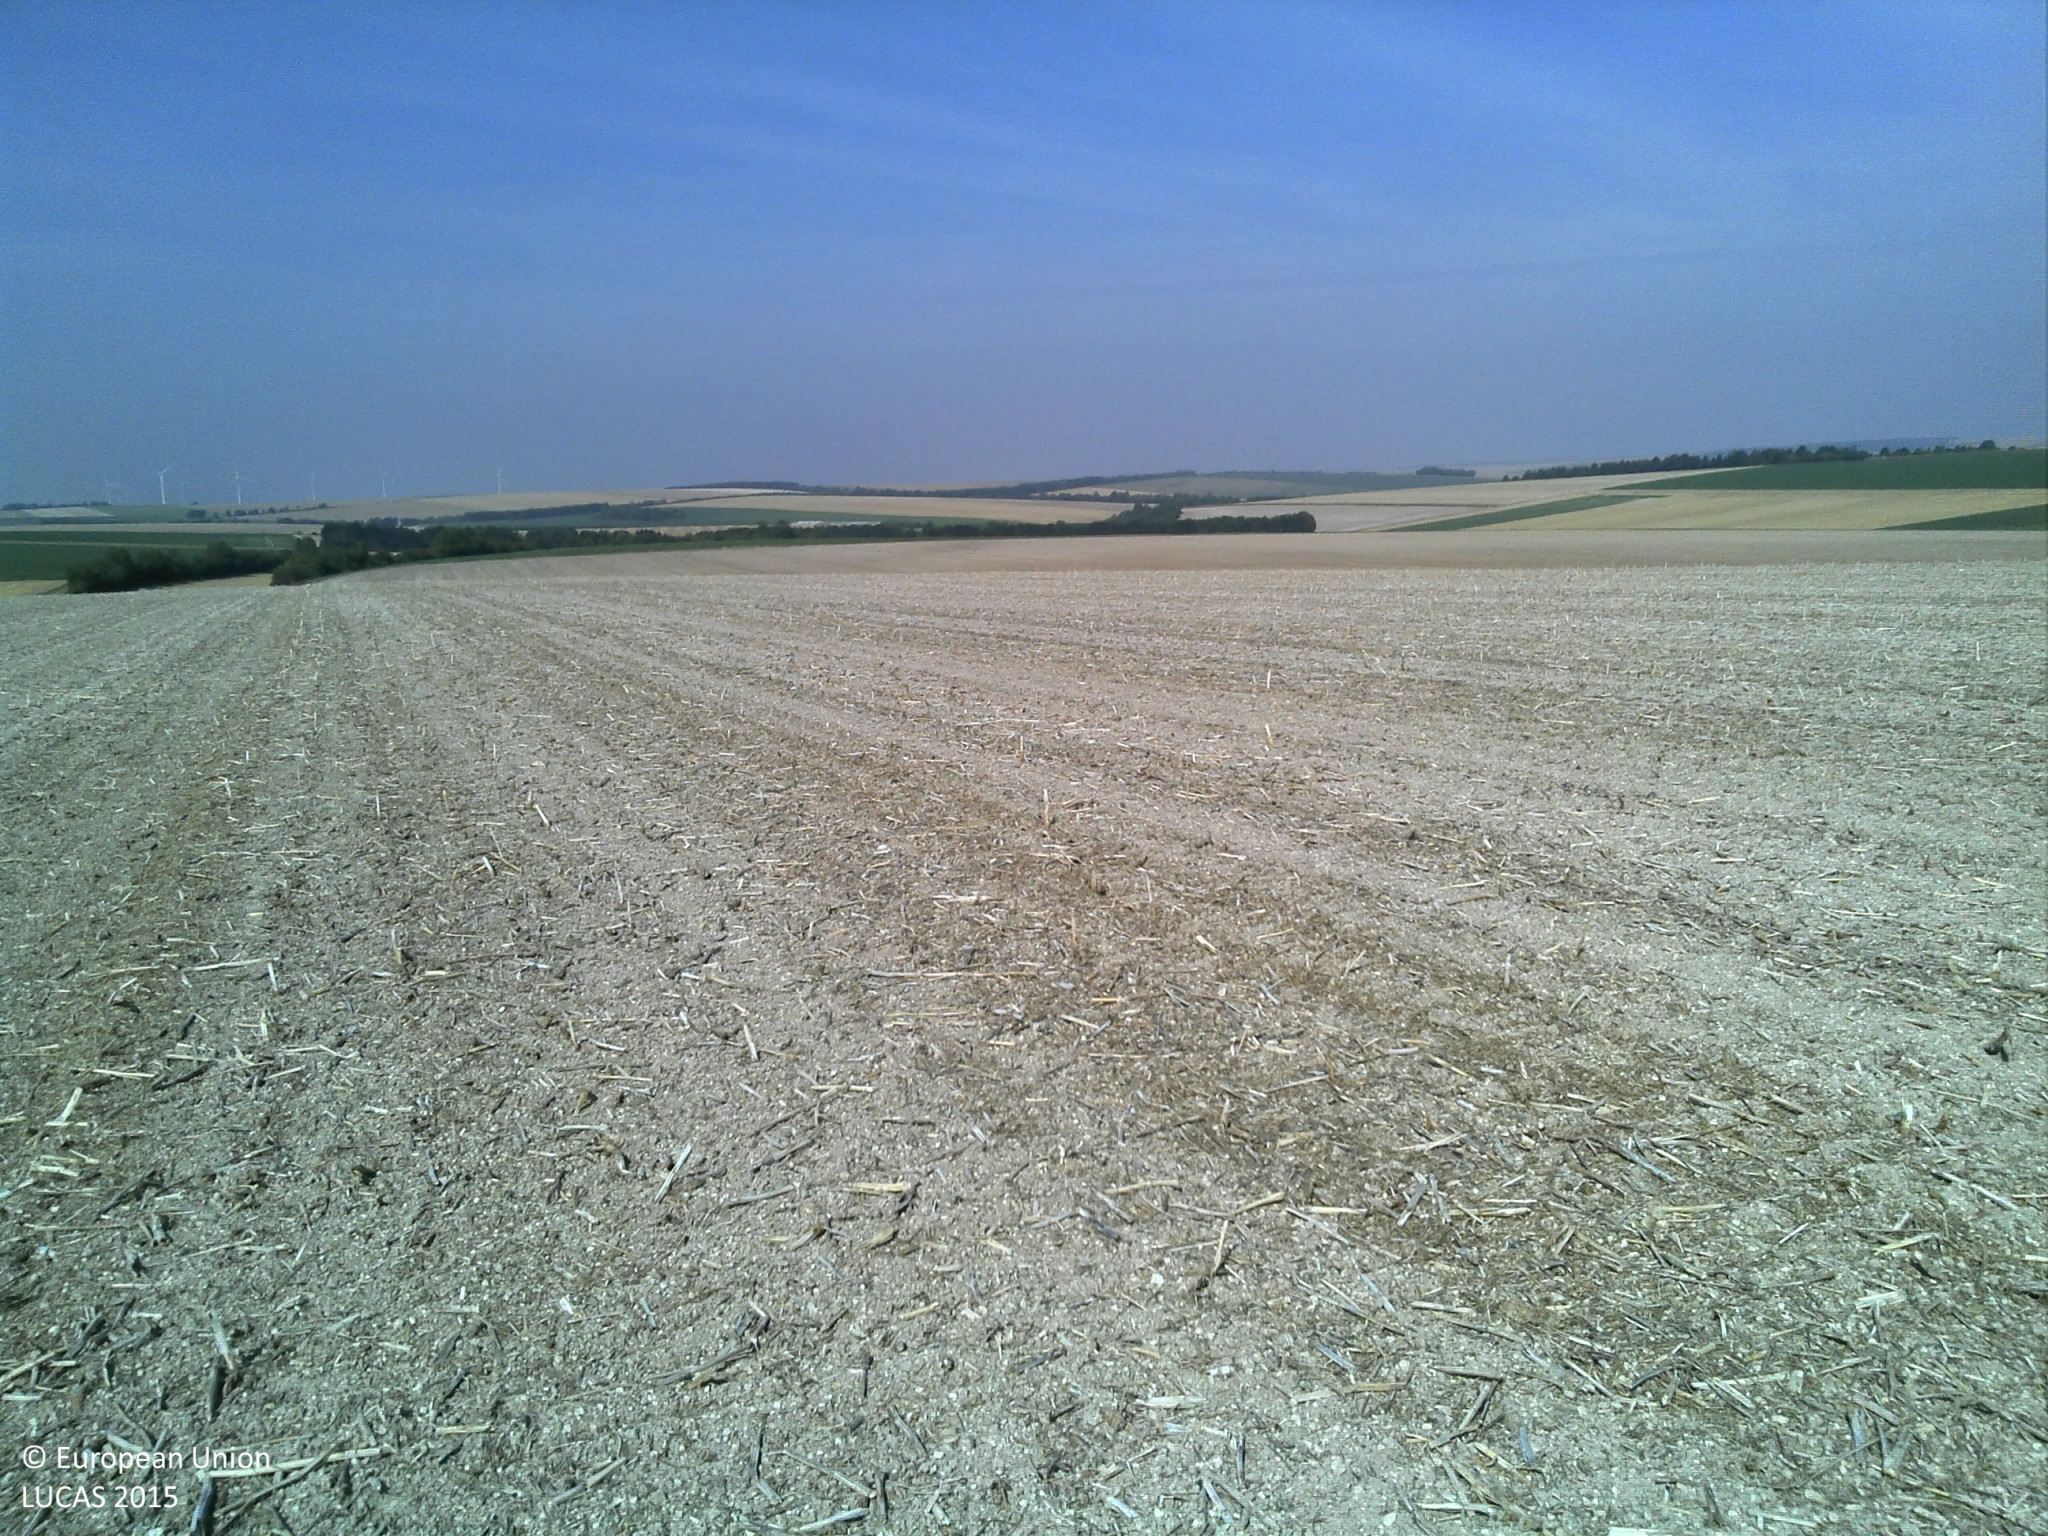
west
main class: Cropland
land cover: Rape and turnip rape
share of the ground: > 75 %
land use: Agriculture (excluding fallow land and kitchen gardens)
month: August
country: FR
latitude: 48.8877
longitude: 4.6647
